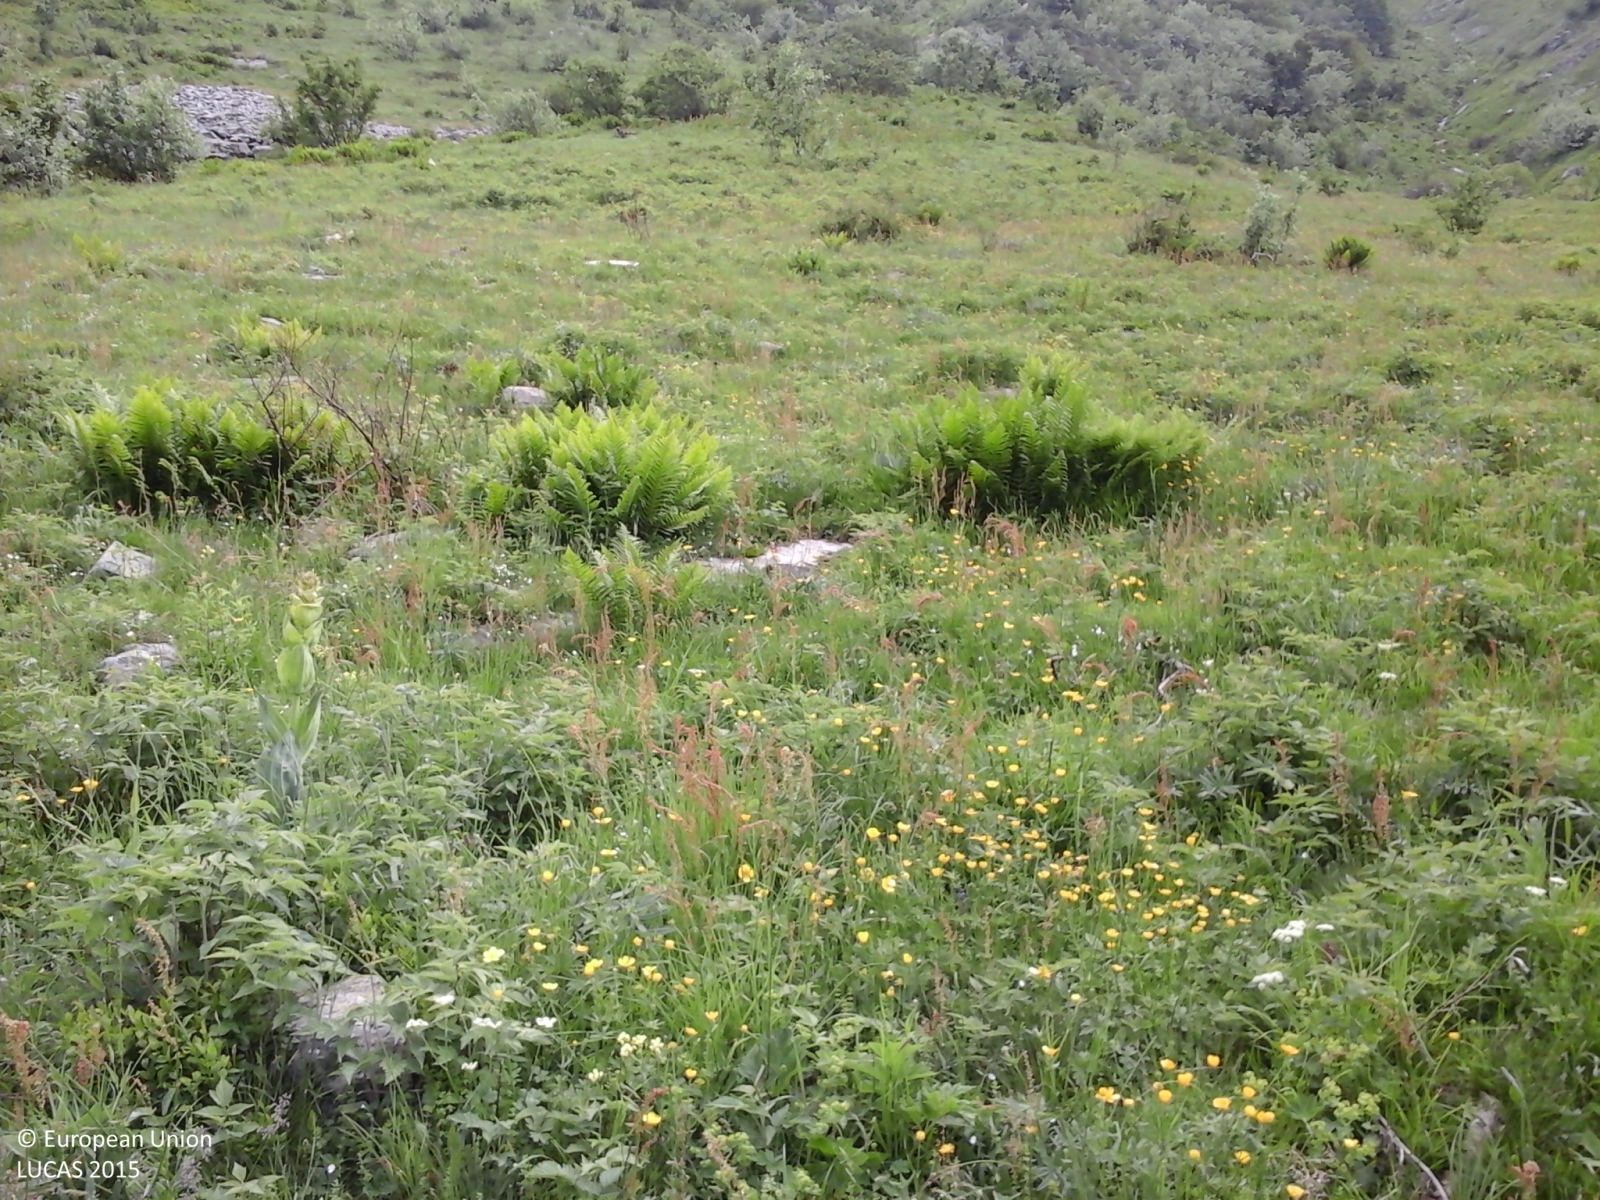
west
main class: Grassland
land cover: Grassland without tree/shrub cover
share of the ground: > 75 %
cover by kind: herbaceous plants 75 %, consolidated bare surface 15 %, shrubs 5 %, lichens and mosses 5 %
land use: Agriculture (excluding fallow land and kitchen gardens)
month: June
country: IT
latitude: 44.2171
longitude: 7.7145
